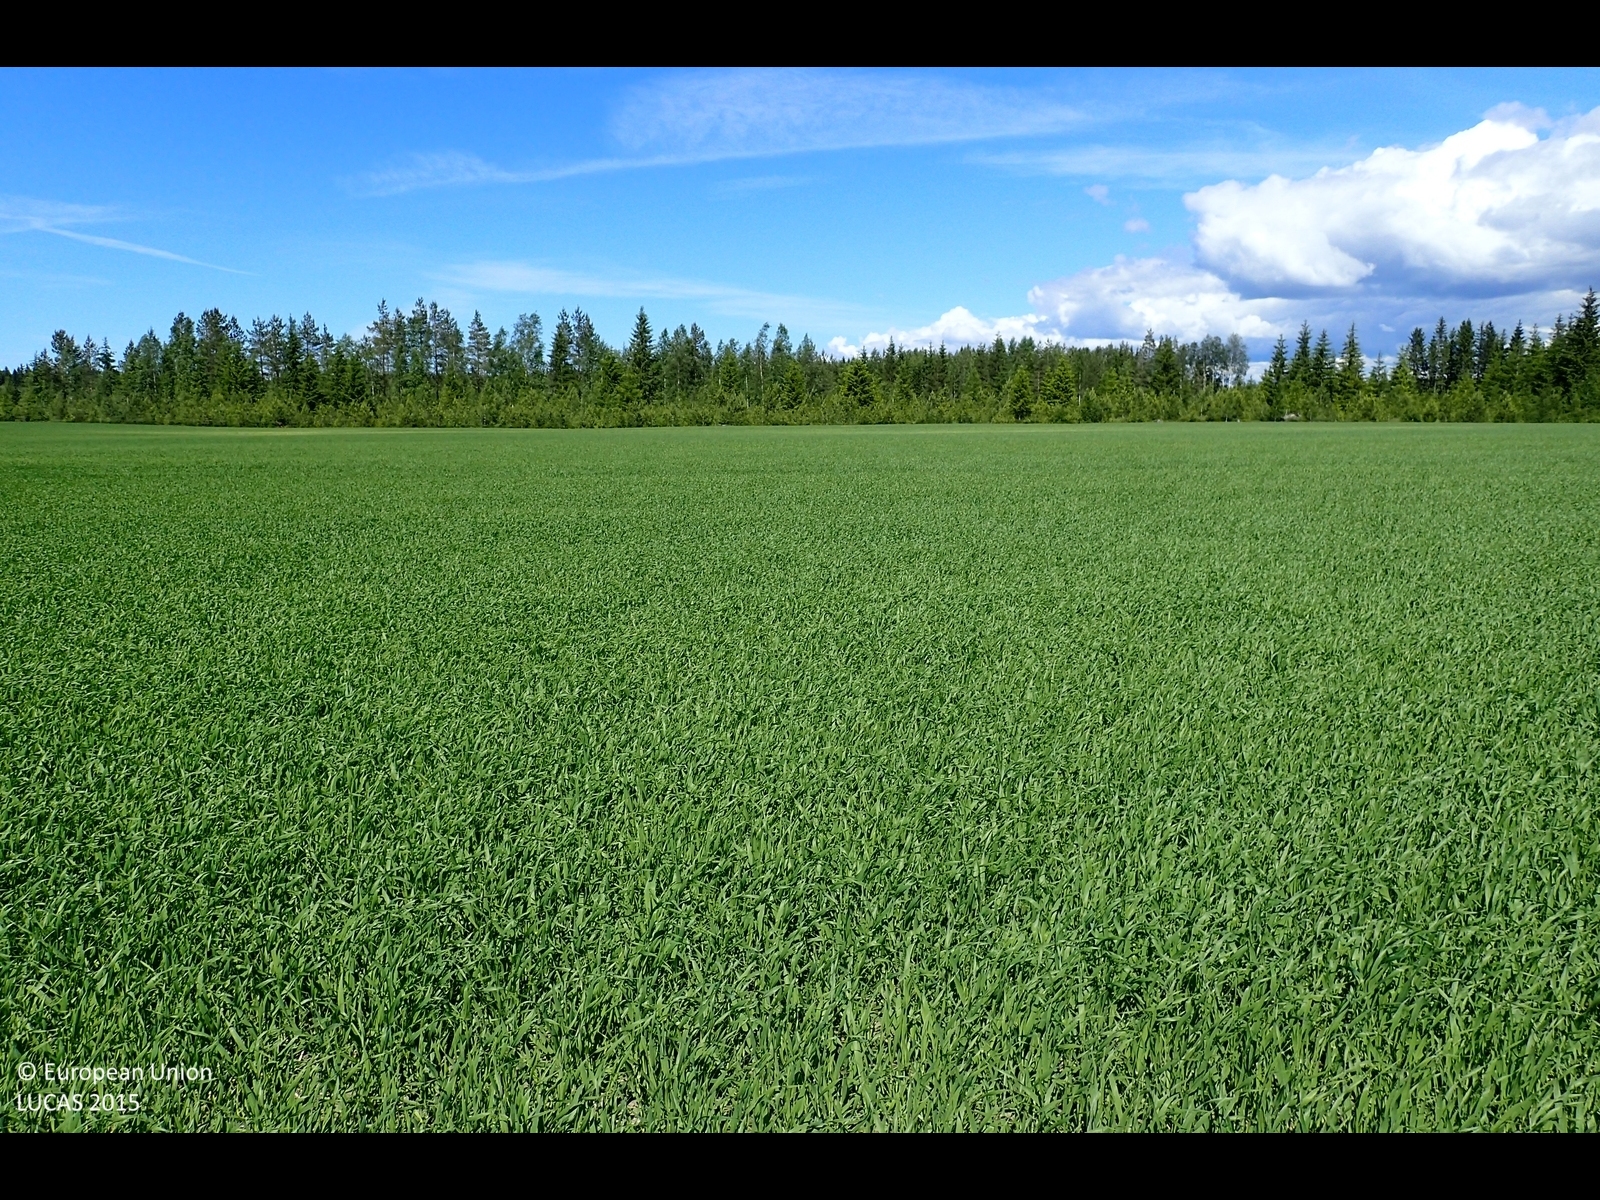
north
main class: Cropland
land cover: Barley
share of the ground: > 75 %
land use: Agriculture (excluding fallow land and kitchen gardens)
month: July
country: FI
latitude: 62.5183
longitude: 21.7198
